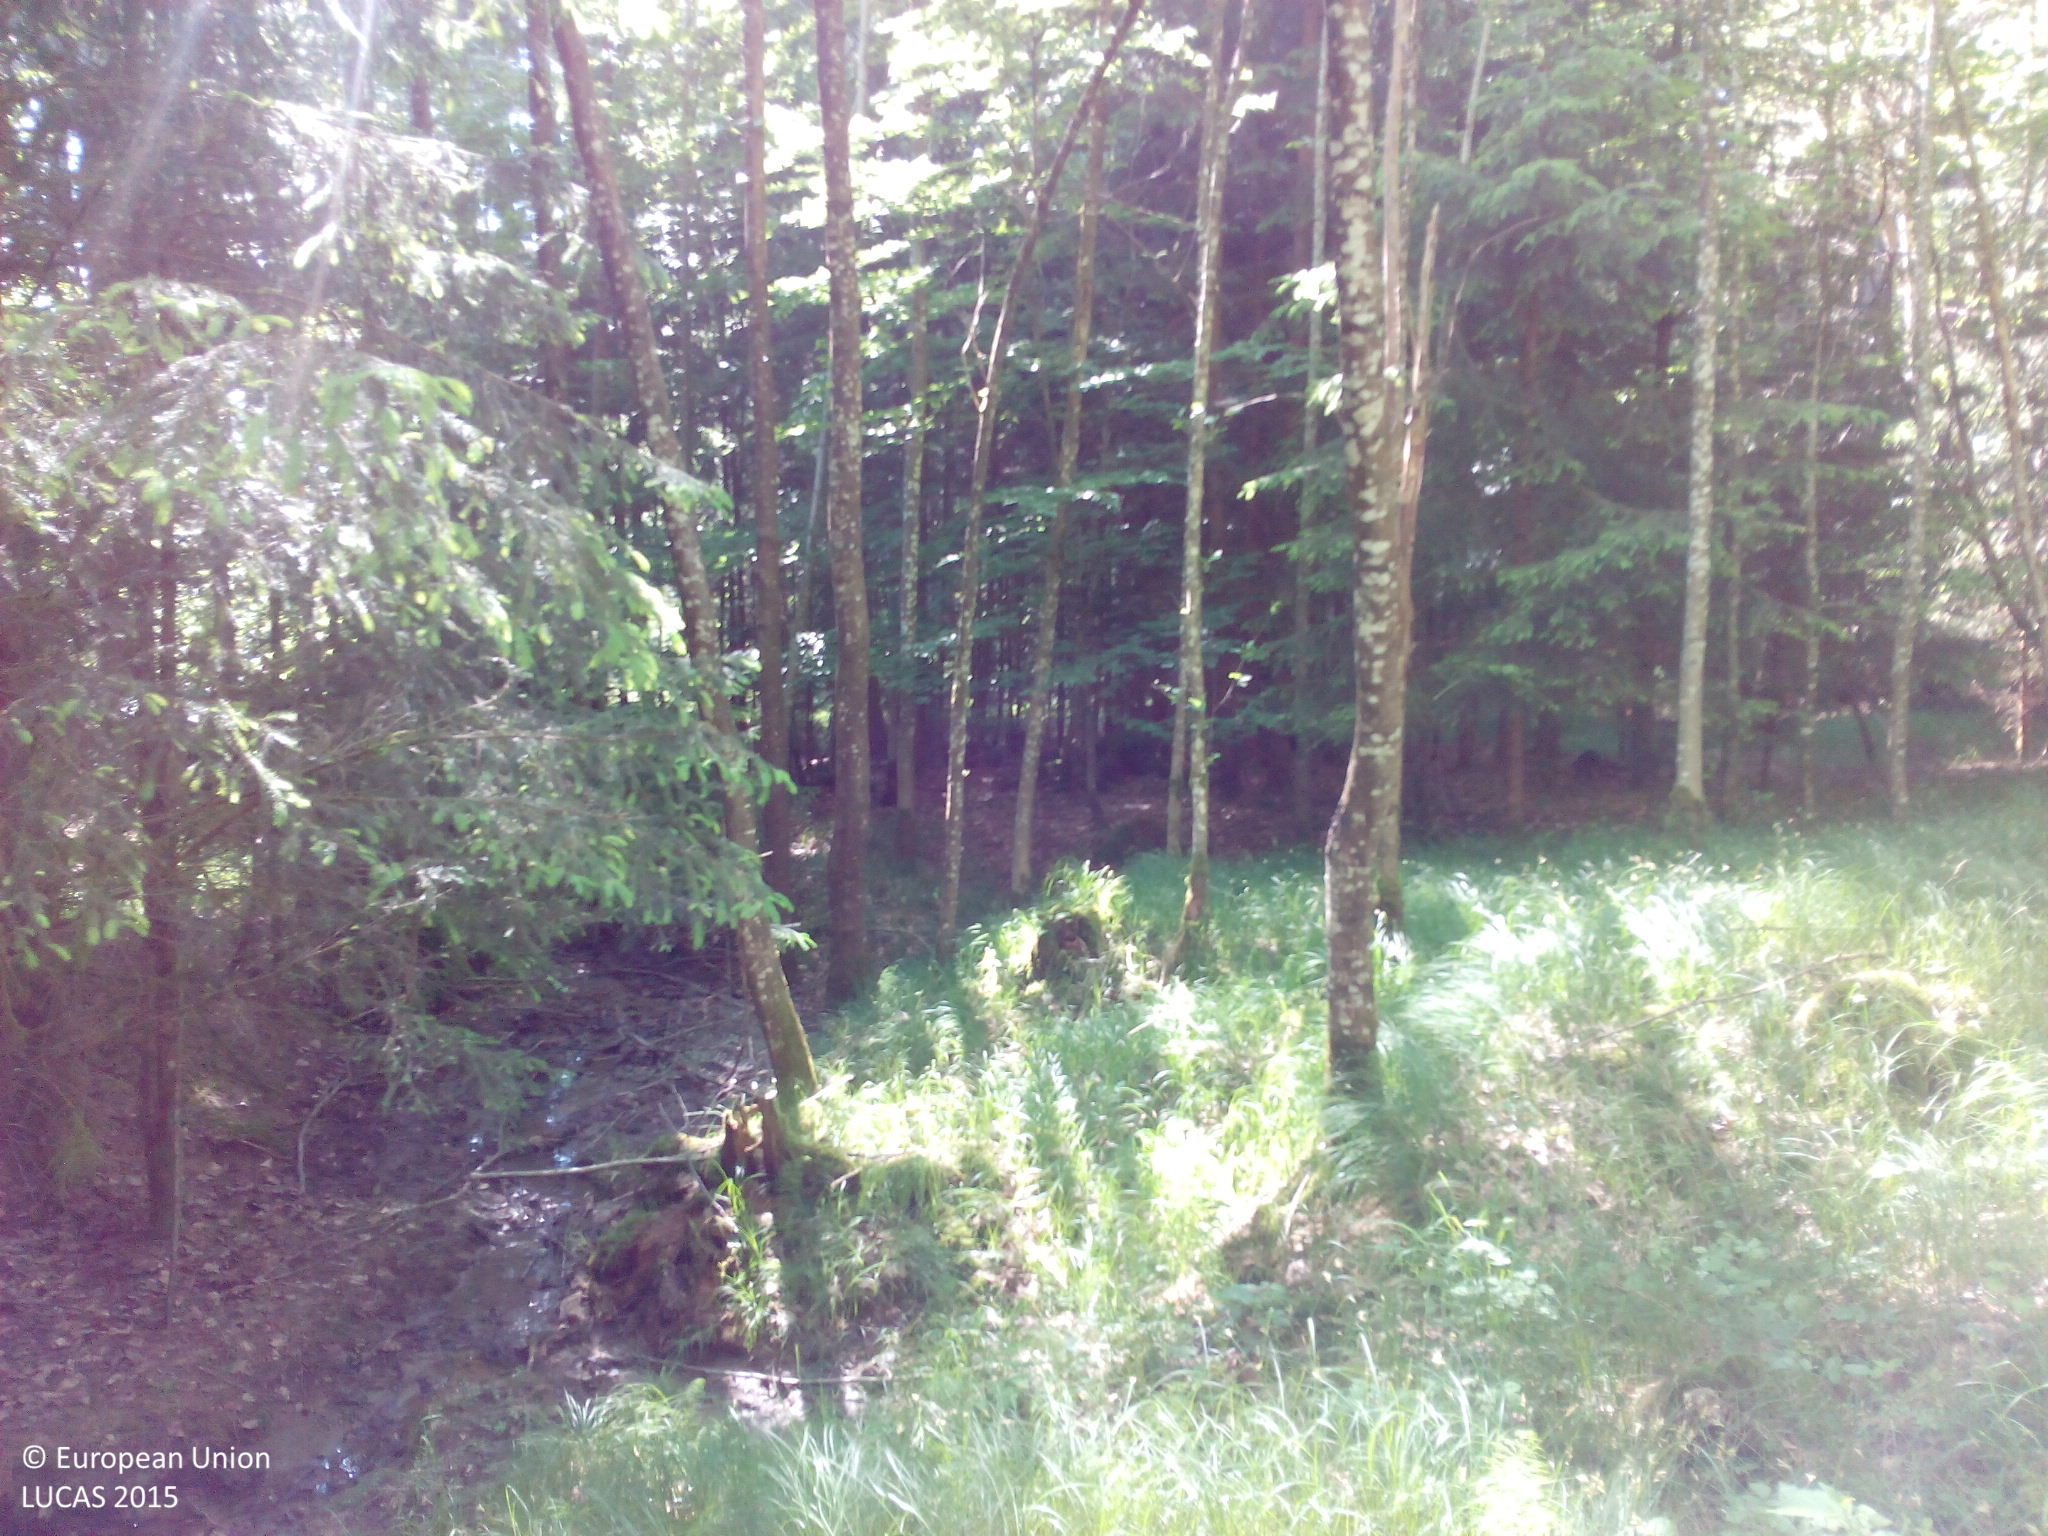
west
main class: Woodland
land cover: Broadleaved woodland
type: mire and swamp forests
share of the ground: > 75 %
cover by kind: broadleaved forest trees 70 %, coniferous forest trees 10 %, shrubs 10 %, herbaceous plants 10 %
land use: Forestry
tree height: > 5 m
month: June
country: DE
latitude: 48.5413
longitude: 12.3153
